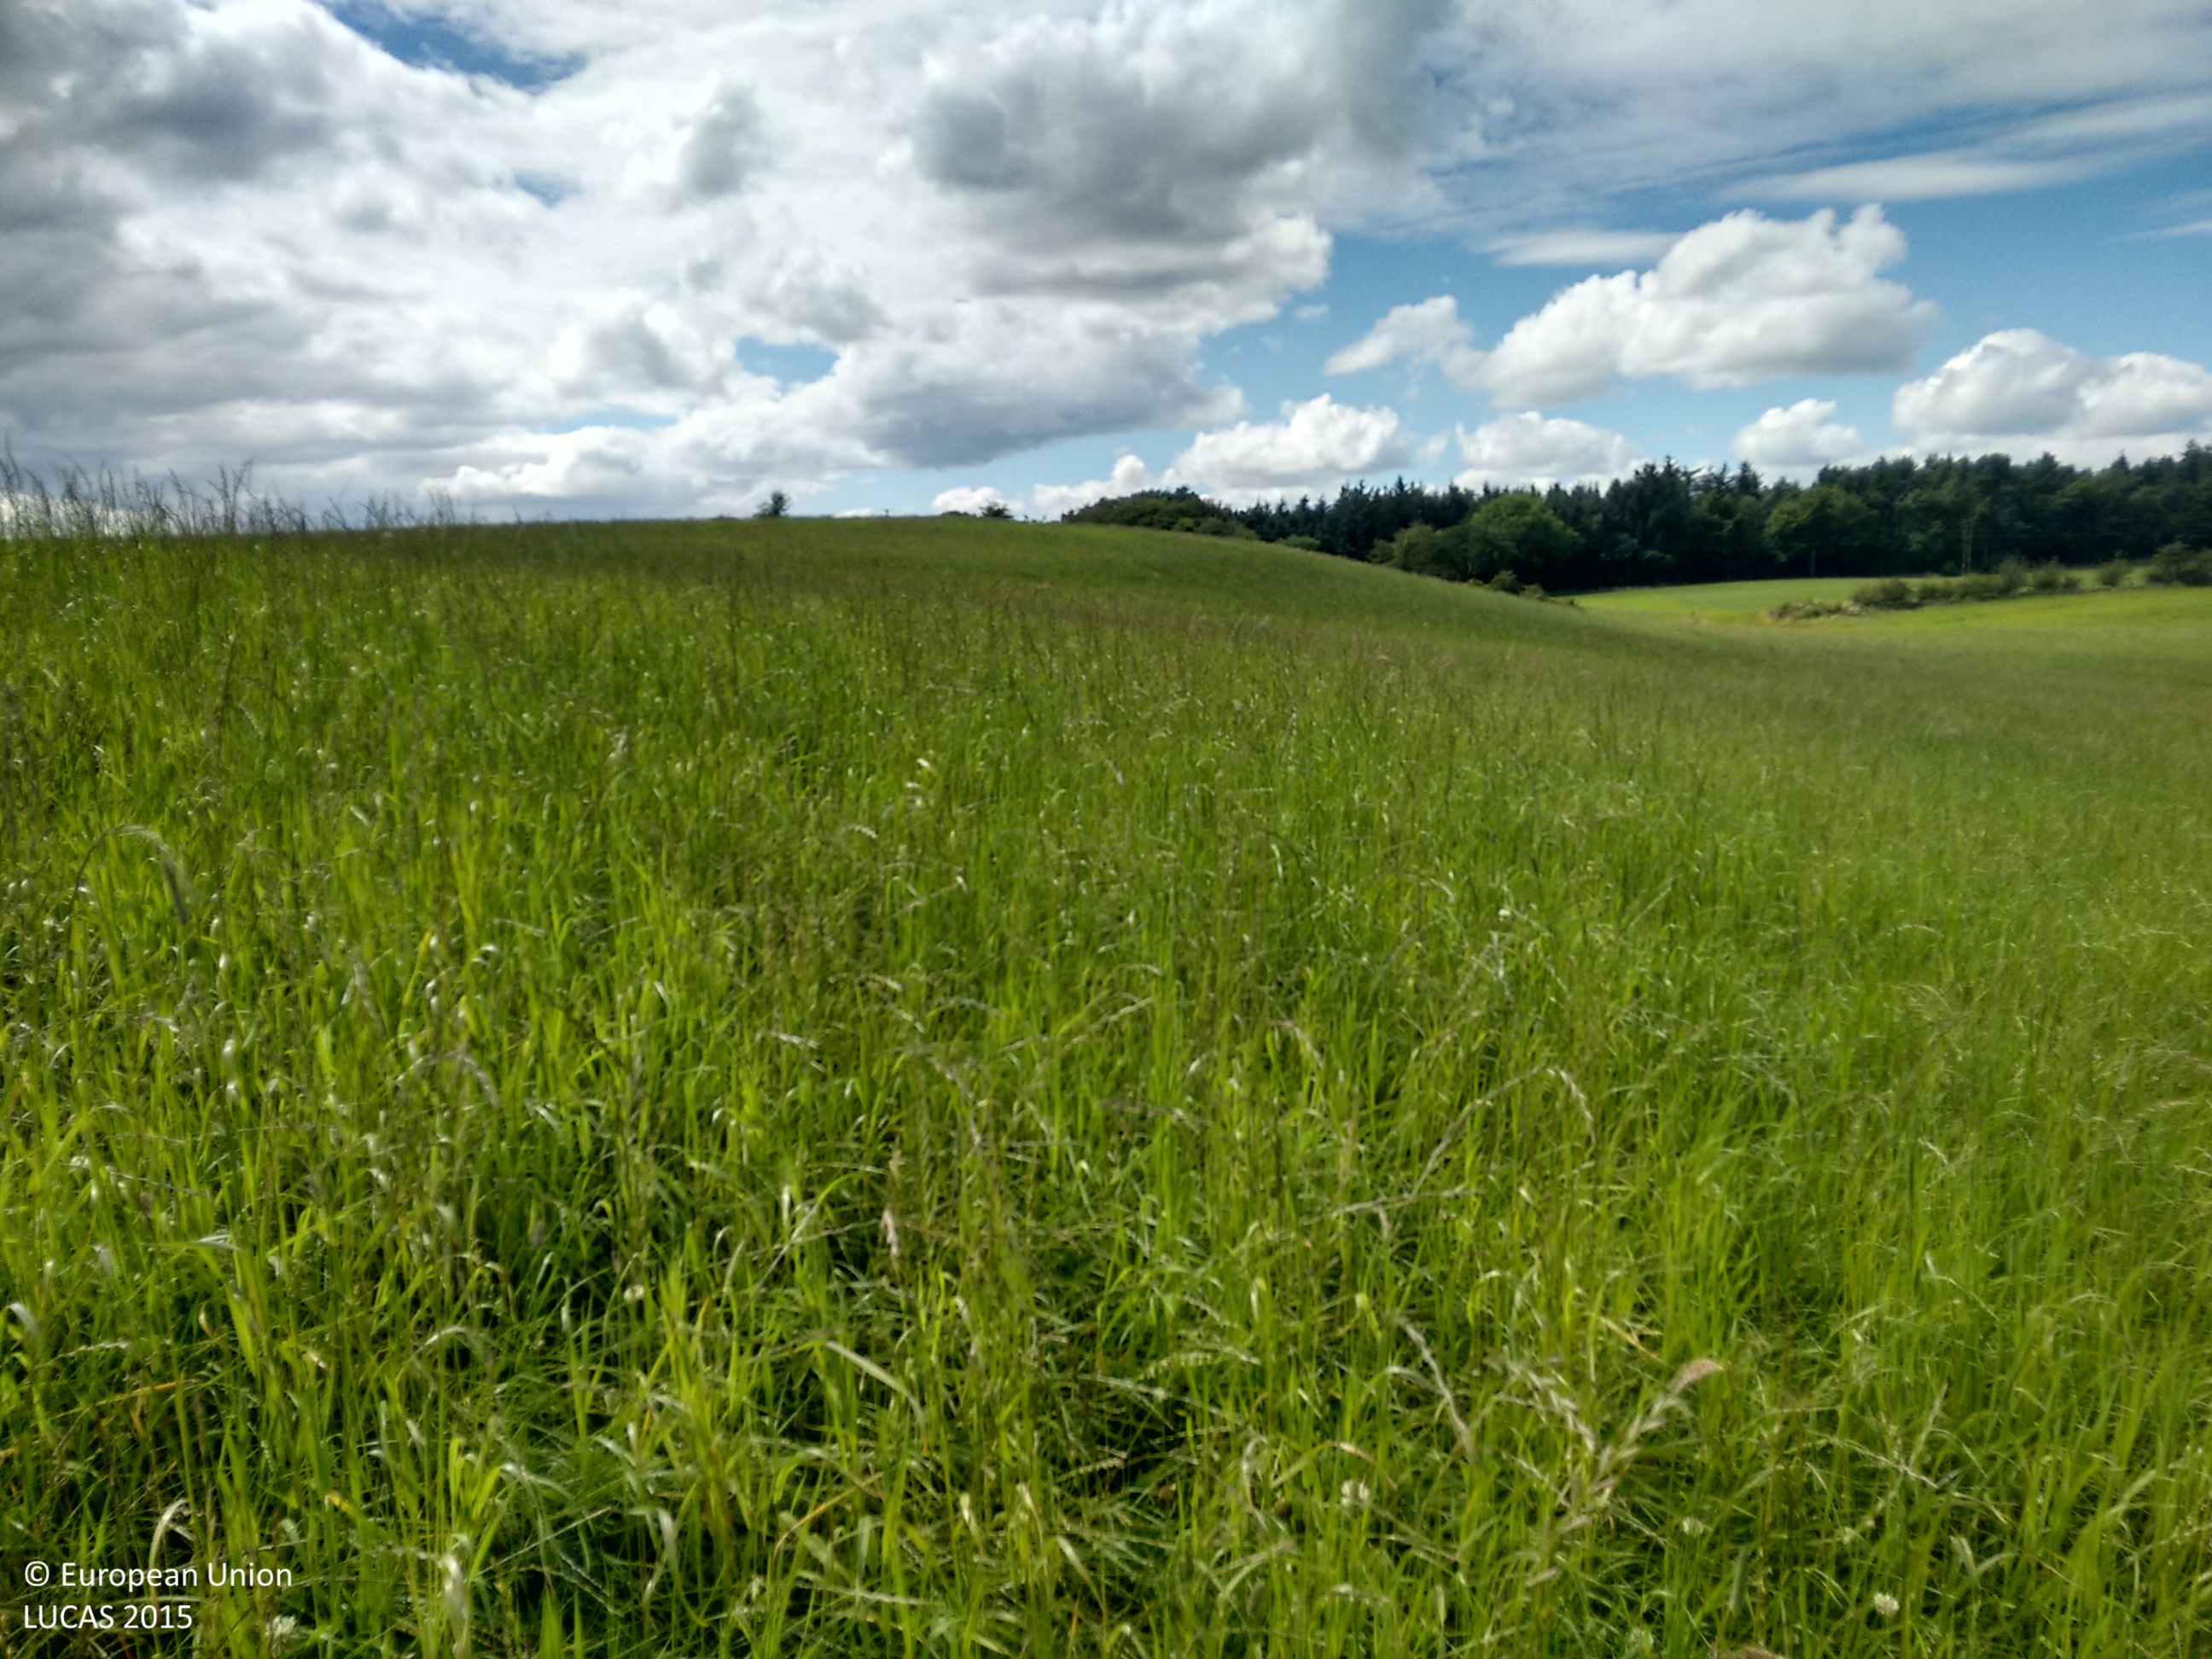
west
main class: Cropland
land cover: Temporary grasslands
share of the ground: > 75 %
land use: Agriculture (excluding fallow land and kitchen gardens)
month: August
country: GB
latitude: 55.9833
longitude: -3.8194
